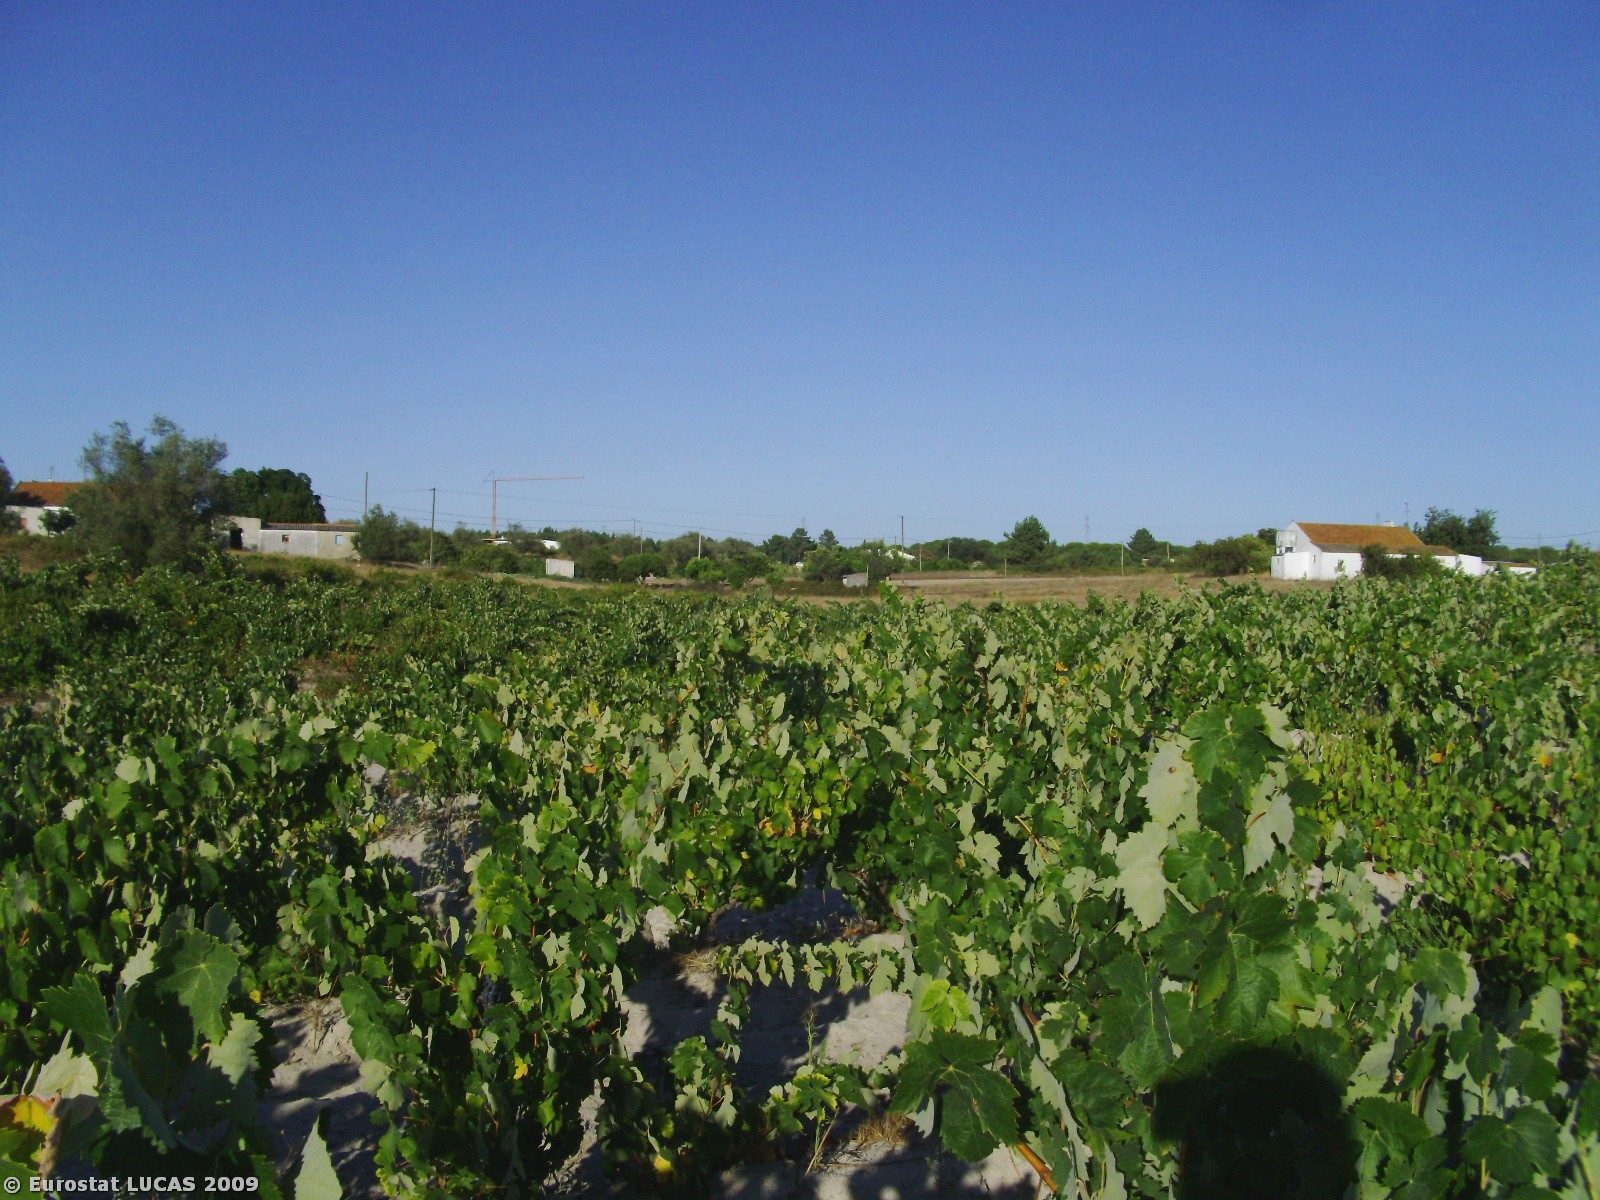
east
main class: Cropland
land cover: Vineyards
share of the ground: 25 - 50 %
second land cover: Bare land
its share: 25 - 50 %
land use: Agriculture (excluding fallow land and kitchen gardens)
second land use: Fallow land
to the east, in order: Vineyards; Bare land; Vineyards; Spontaneously vegetated surfaces; Bare land; Tracks; Bare land; Other structural elements; Bare land; Spontaneously vegetated surfaces; Other structural elements; Vineyards
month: August
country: PT
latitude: 38.6220
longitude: -8.6788
